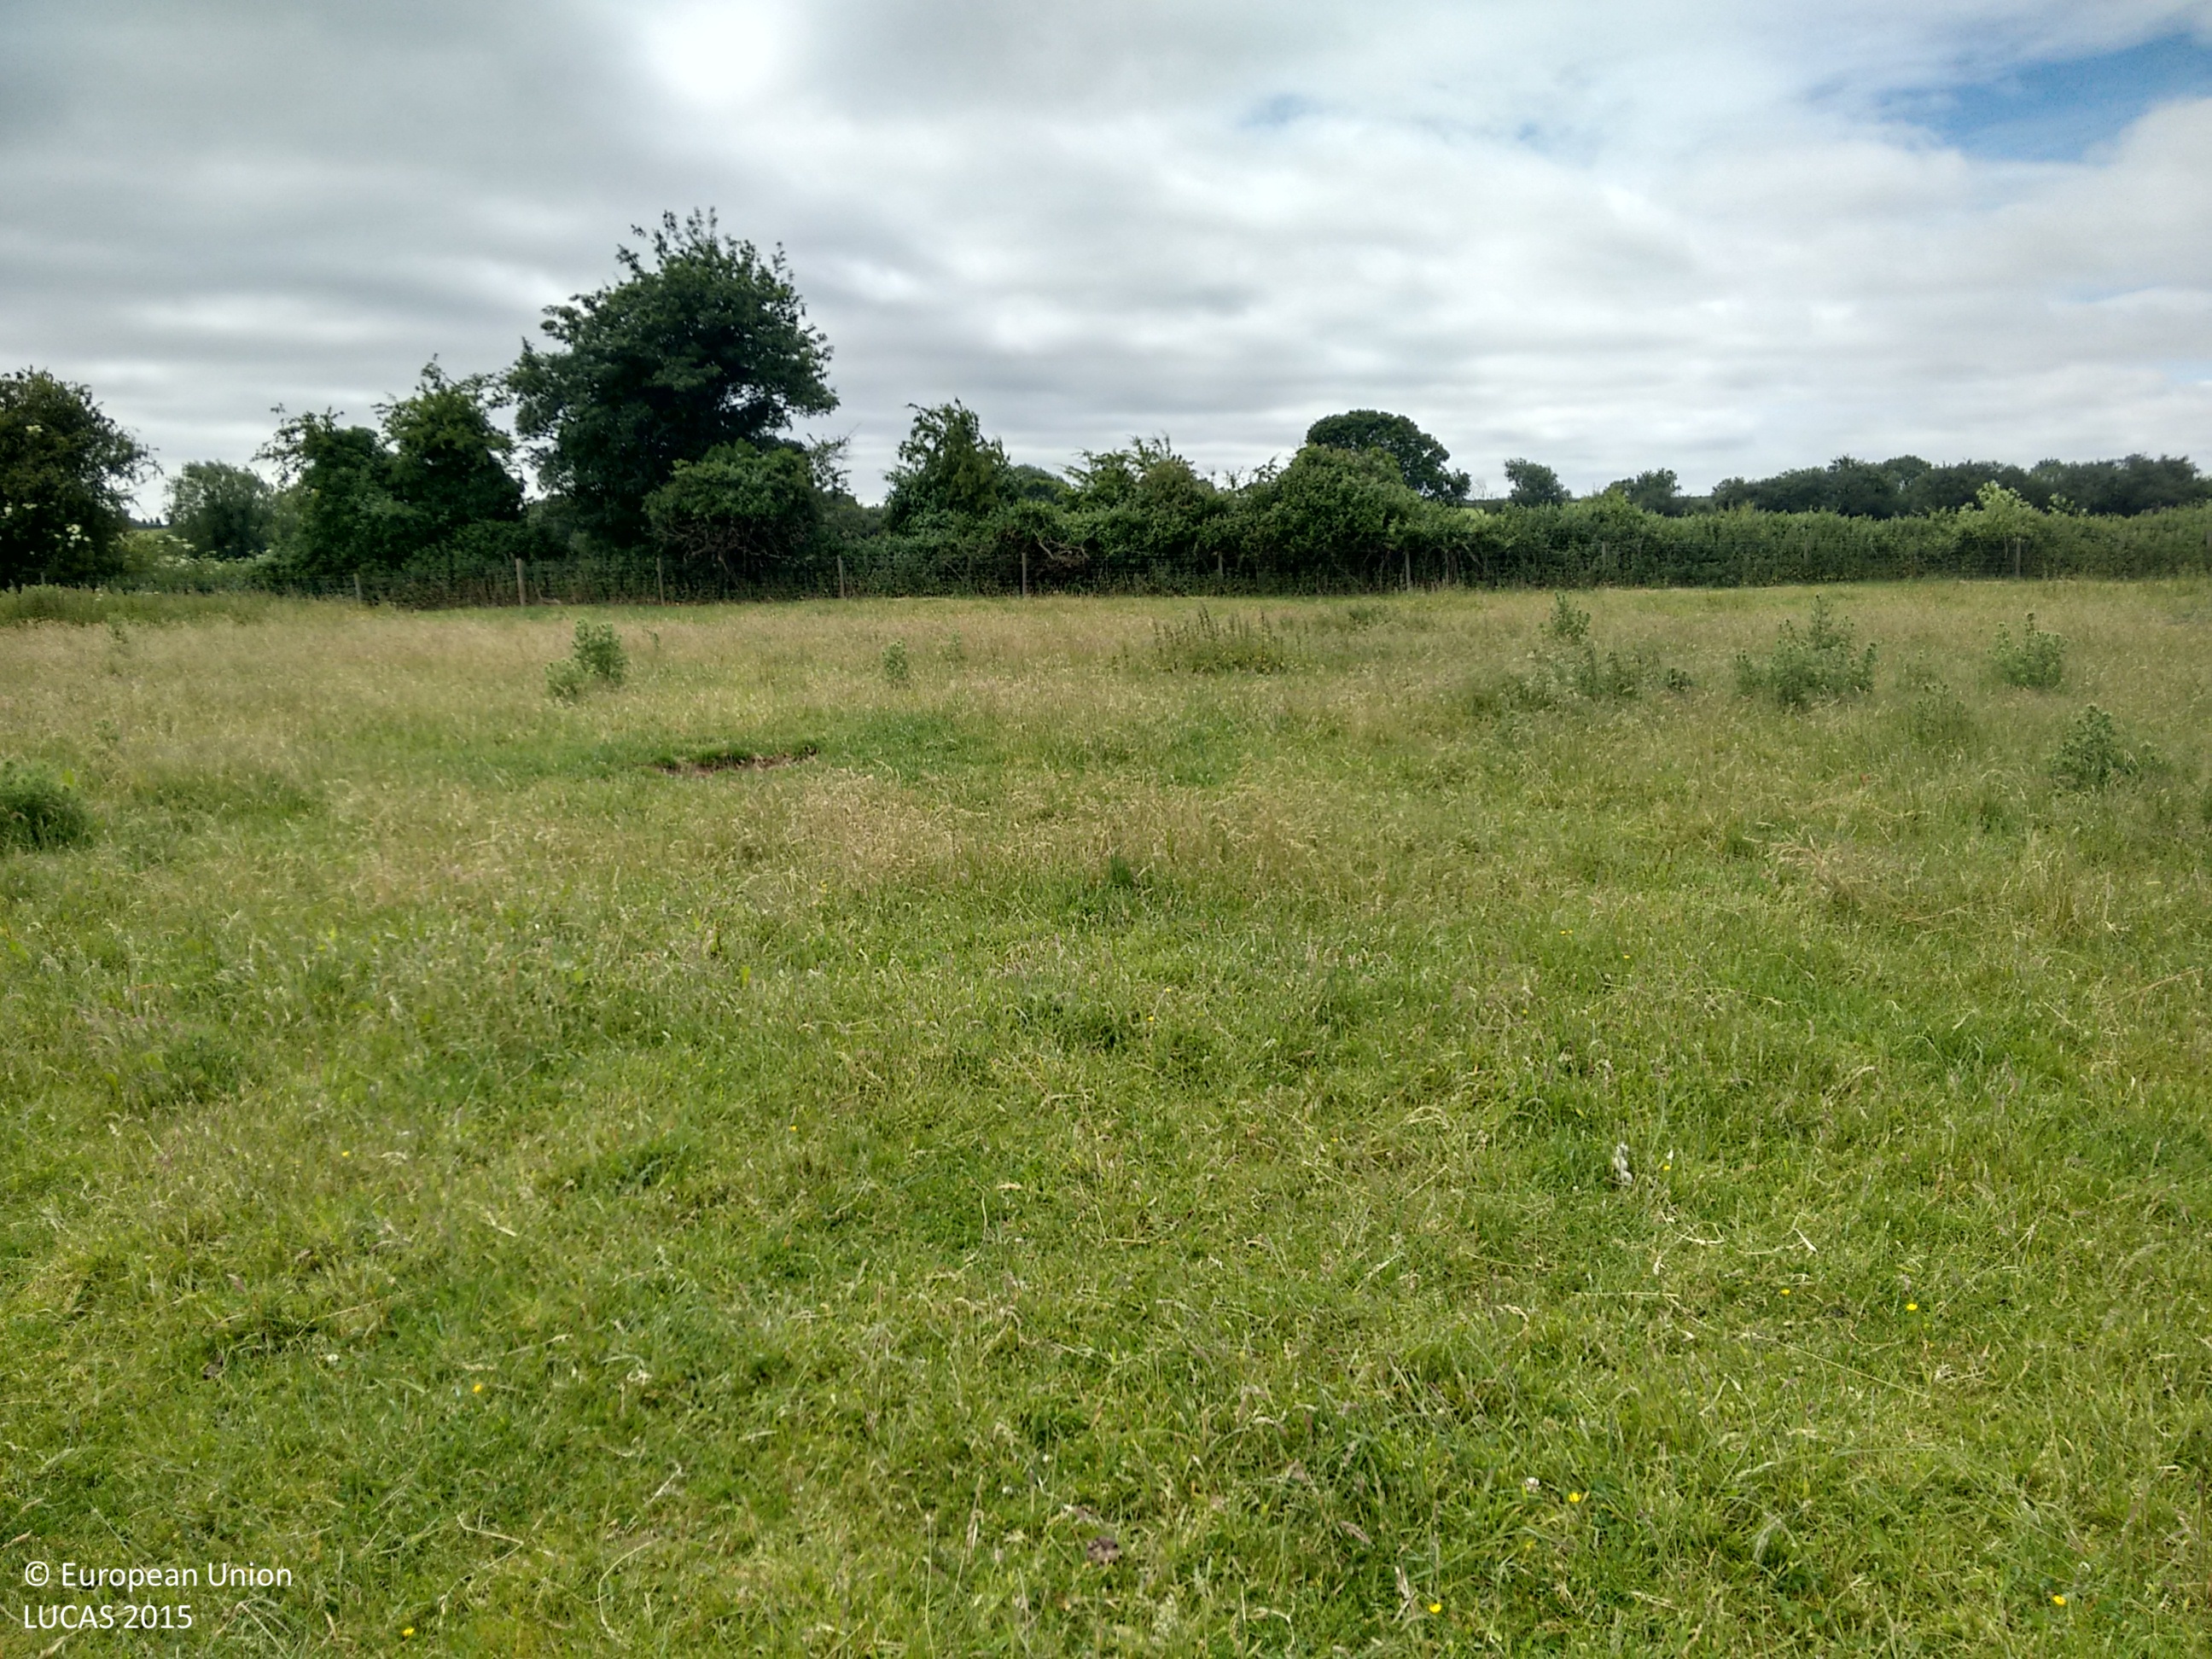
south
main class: Grassland
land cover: Grassland without tree/shrub cover
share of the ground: > 75 %
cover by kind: herbaceous plants 100 %
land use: Agriculture (excluding fallow land and kitchen gardens)
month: June
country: GB
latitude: 51.3488
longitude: -2.1648
